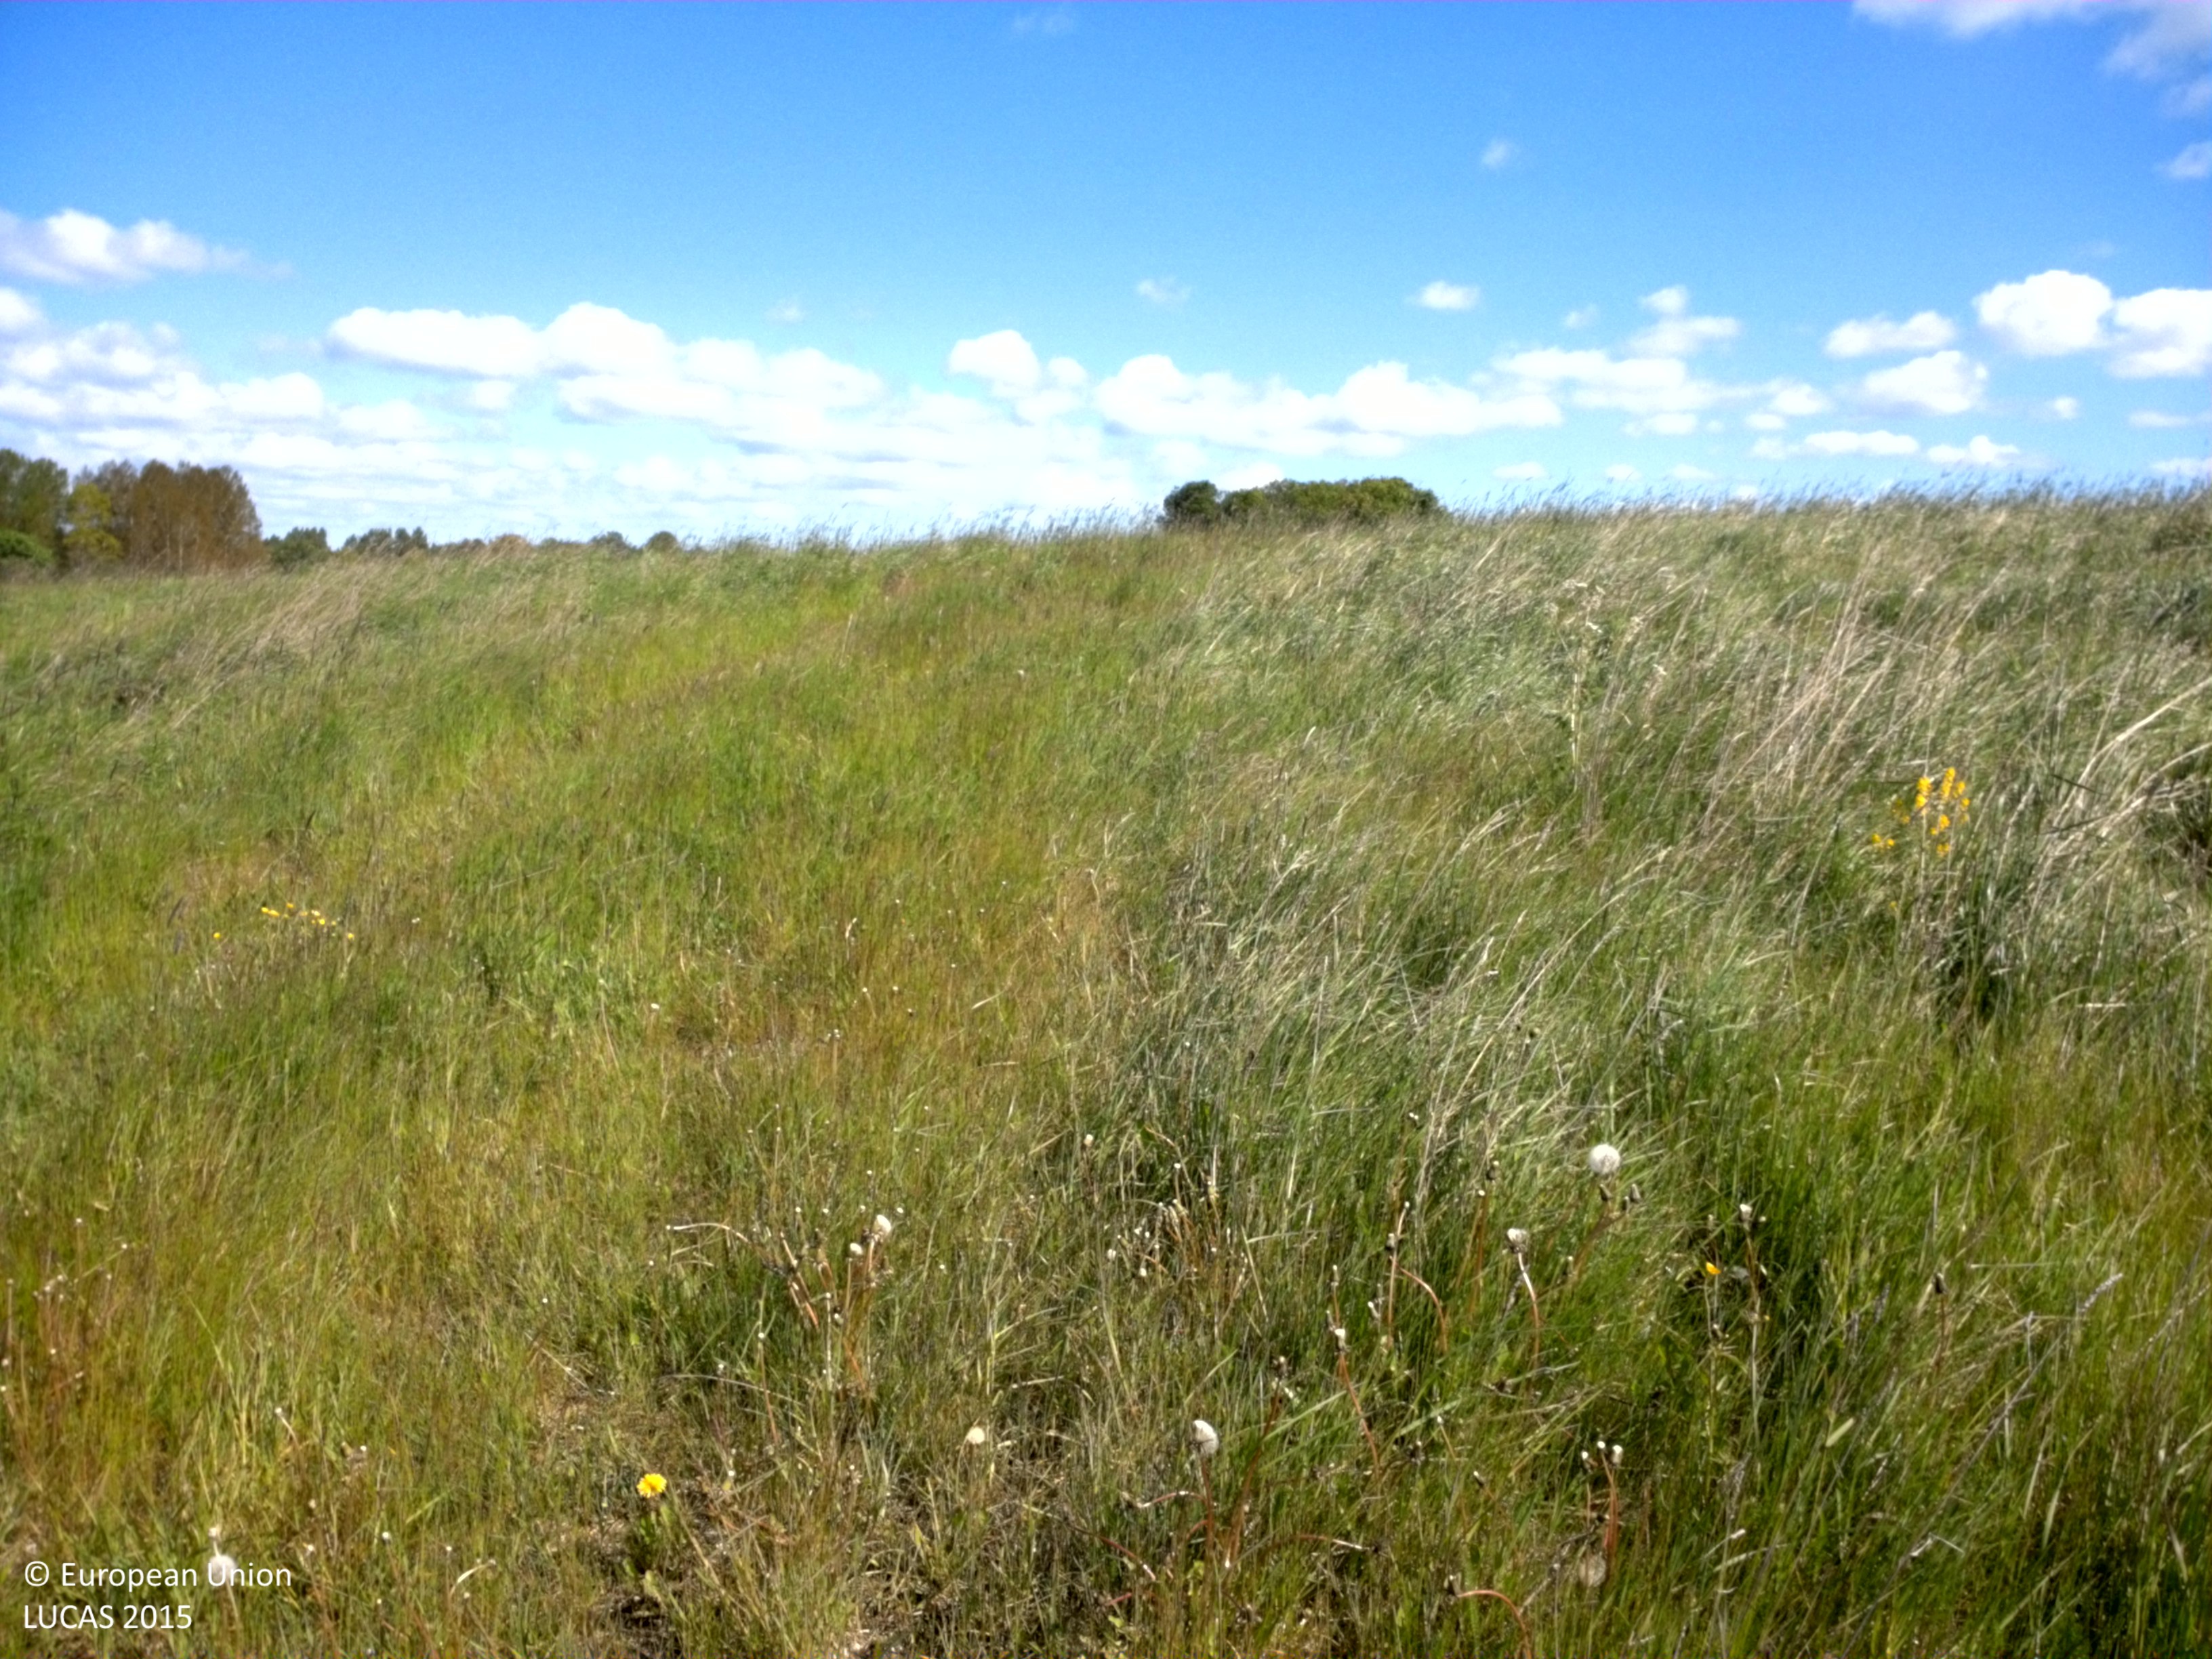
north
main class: Grassland
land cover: Grassland without tree/shrub cover
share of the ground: > 75 %
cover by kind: herbaceous plants 100 %
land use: Community services
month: June
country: SE
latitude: 58.3429
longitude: 13.9059
